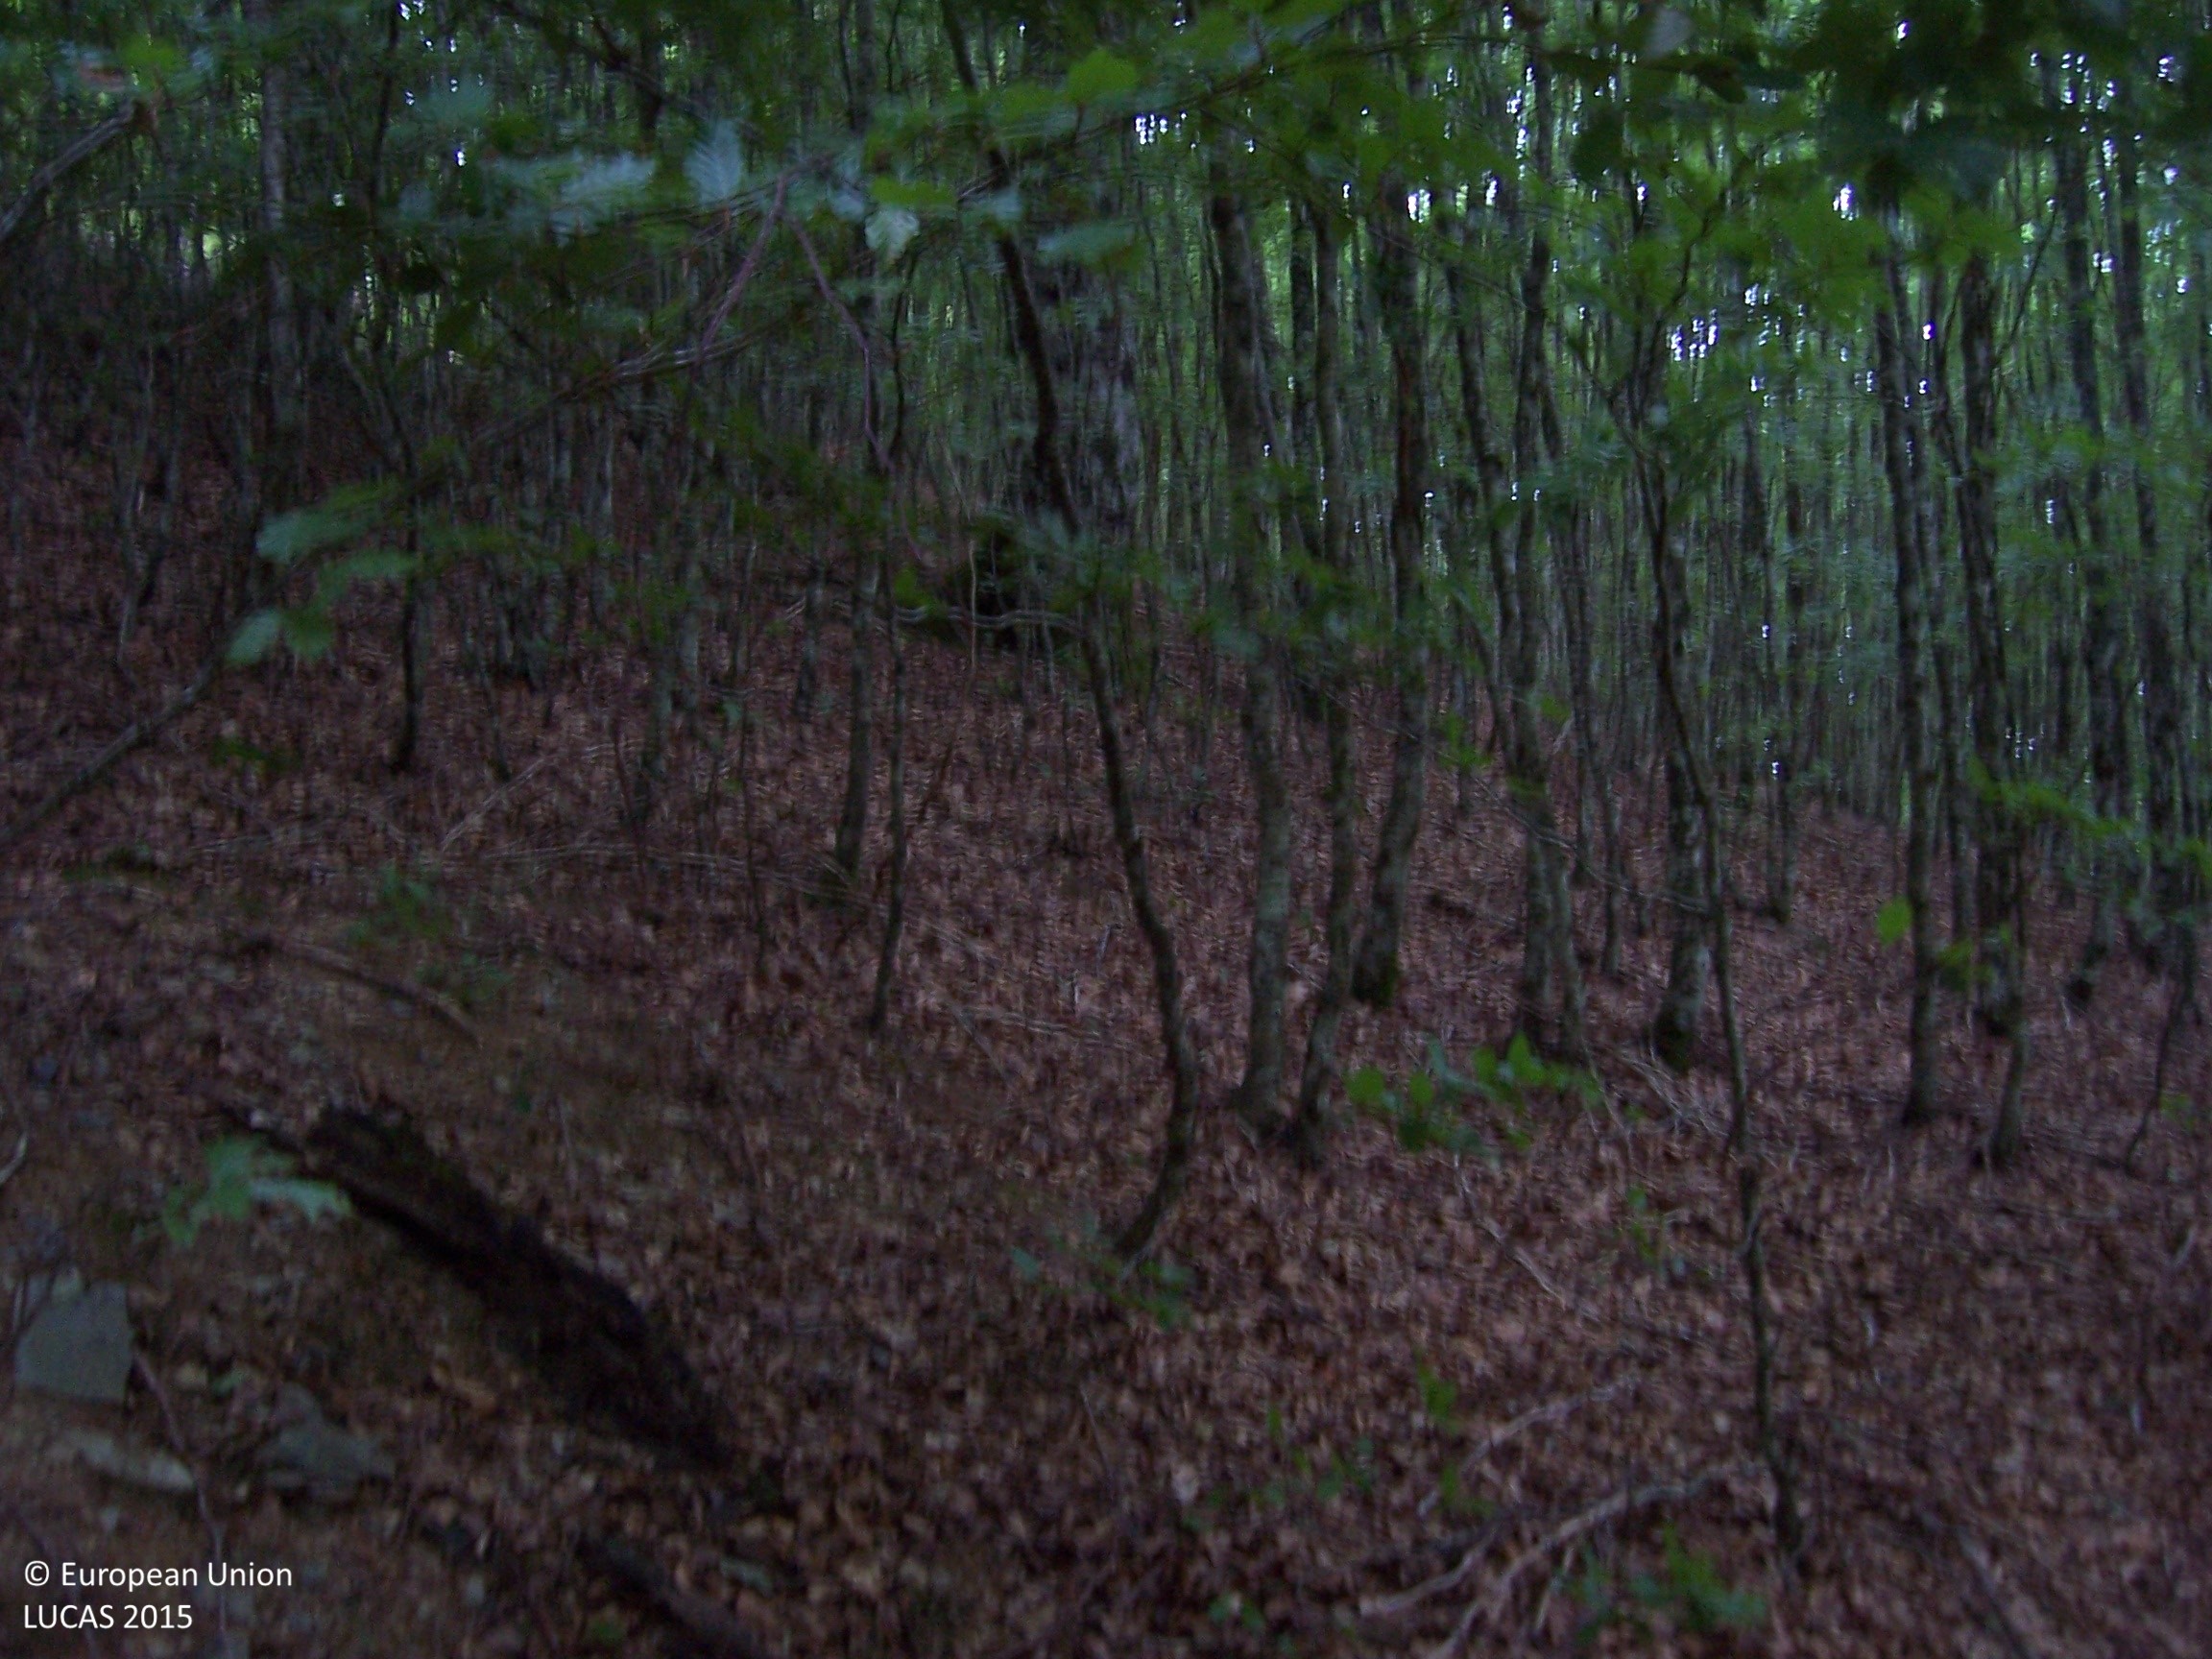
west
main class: Woodland
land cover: Broadleaved woodland
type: mountainous beech forest
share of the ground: > 75 %
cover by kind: broadleaved forest trees 100 %
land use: Forestry
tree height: > 5 m
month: July
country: ES
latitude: 43.0278
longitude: -1.2415
